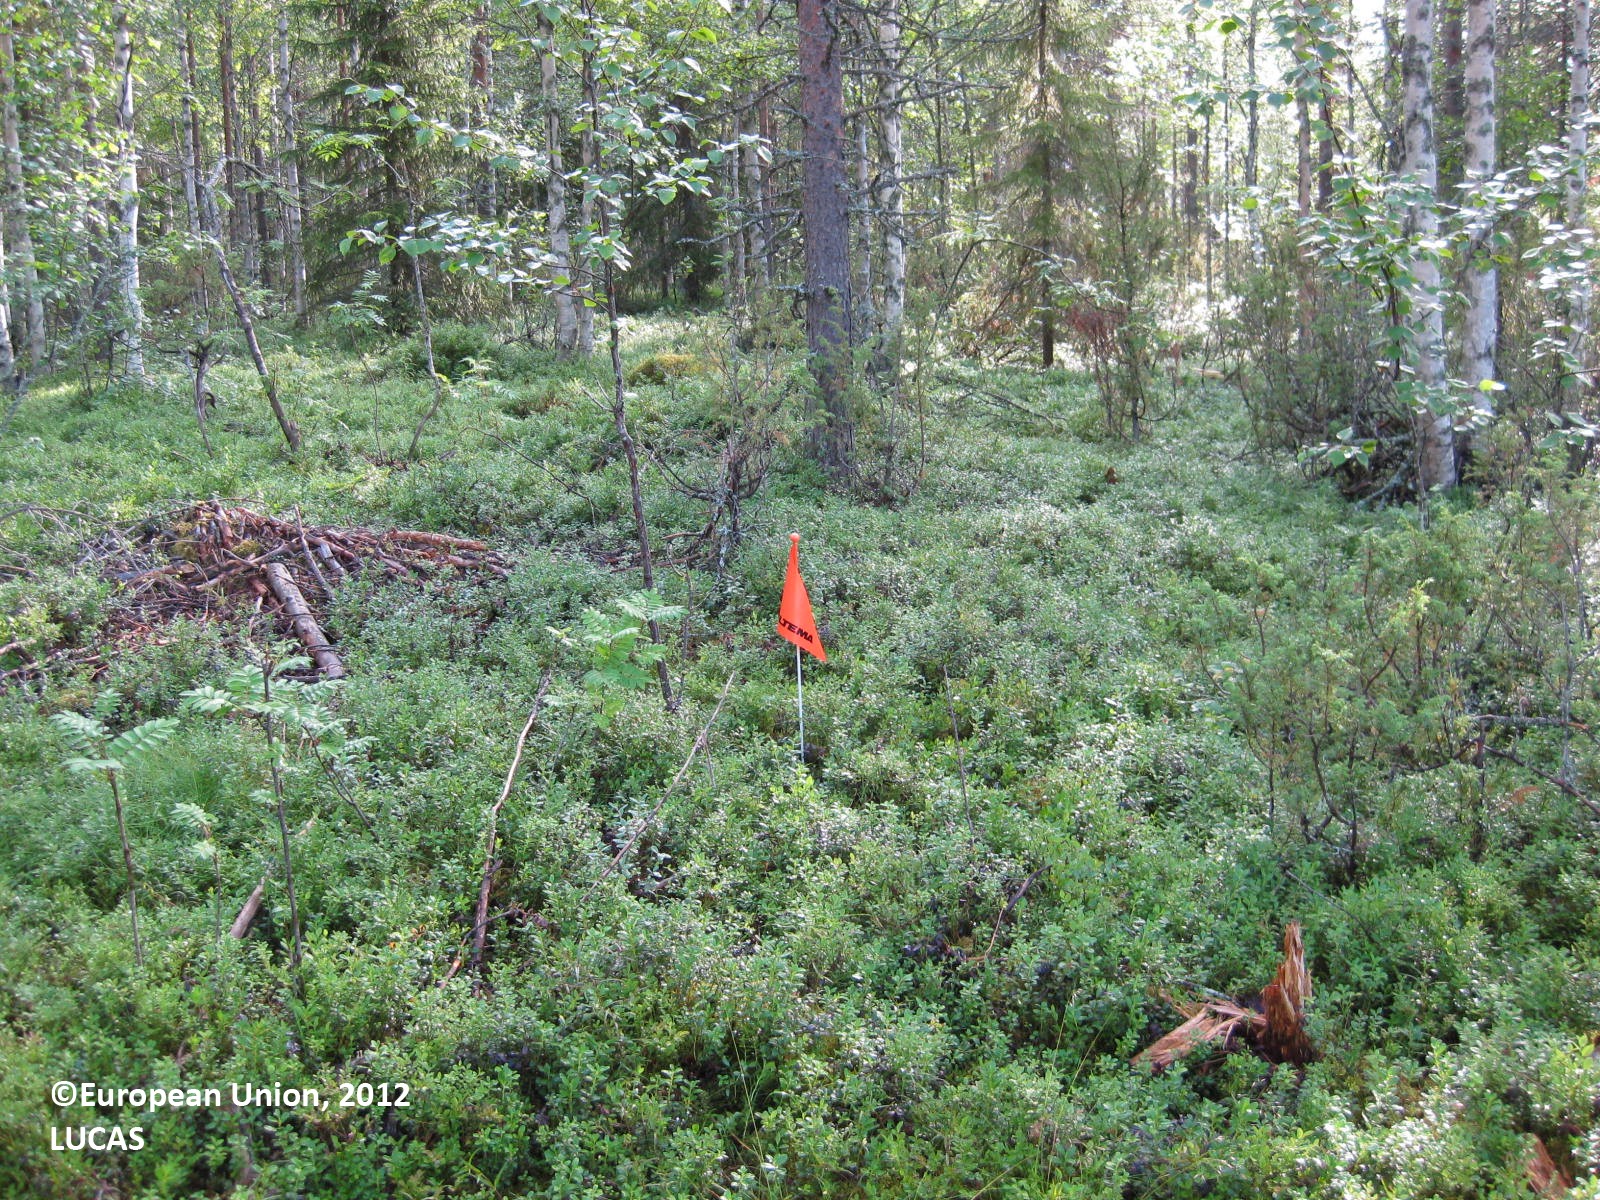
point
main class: Woodland
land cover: Pine dominated mixed woodland
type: boreal forest
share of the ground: 50 - 75 %
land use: Forestry
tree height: > 5 m
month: July
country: FI
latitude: 65.7333
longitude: 28.5870
